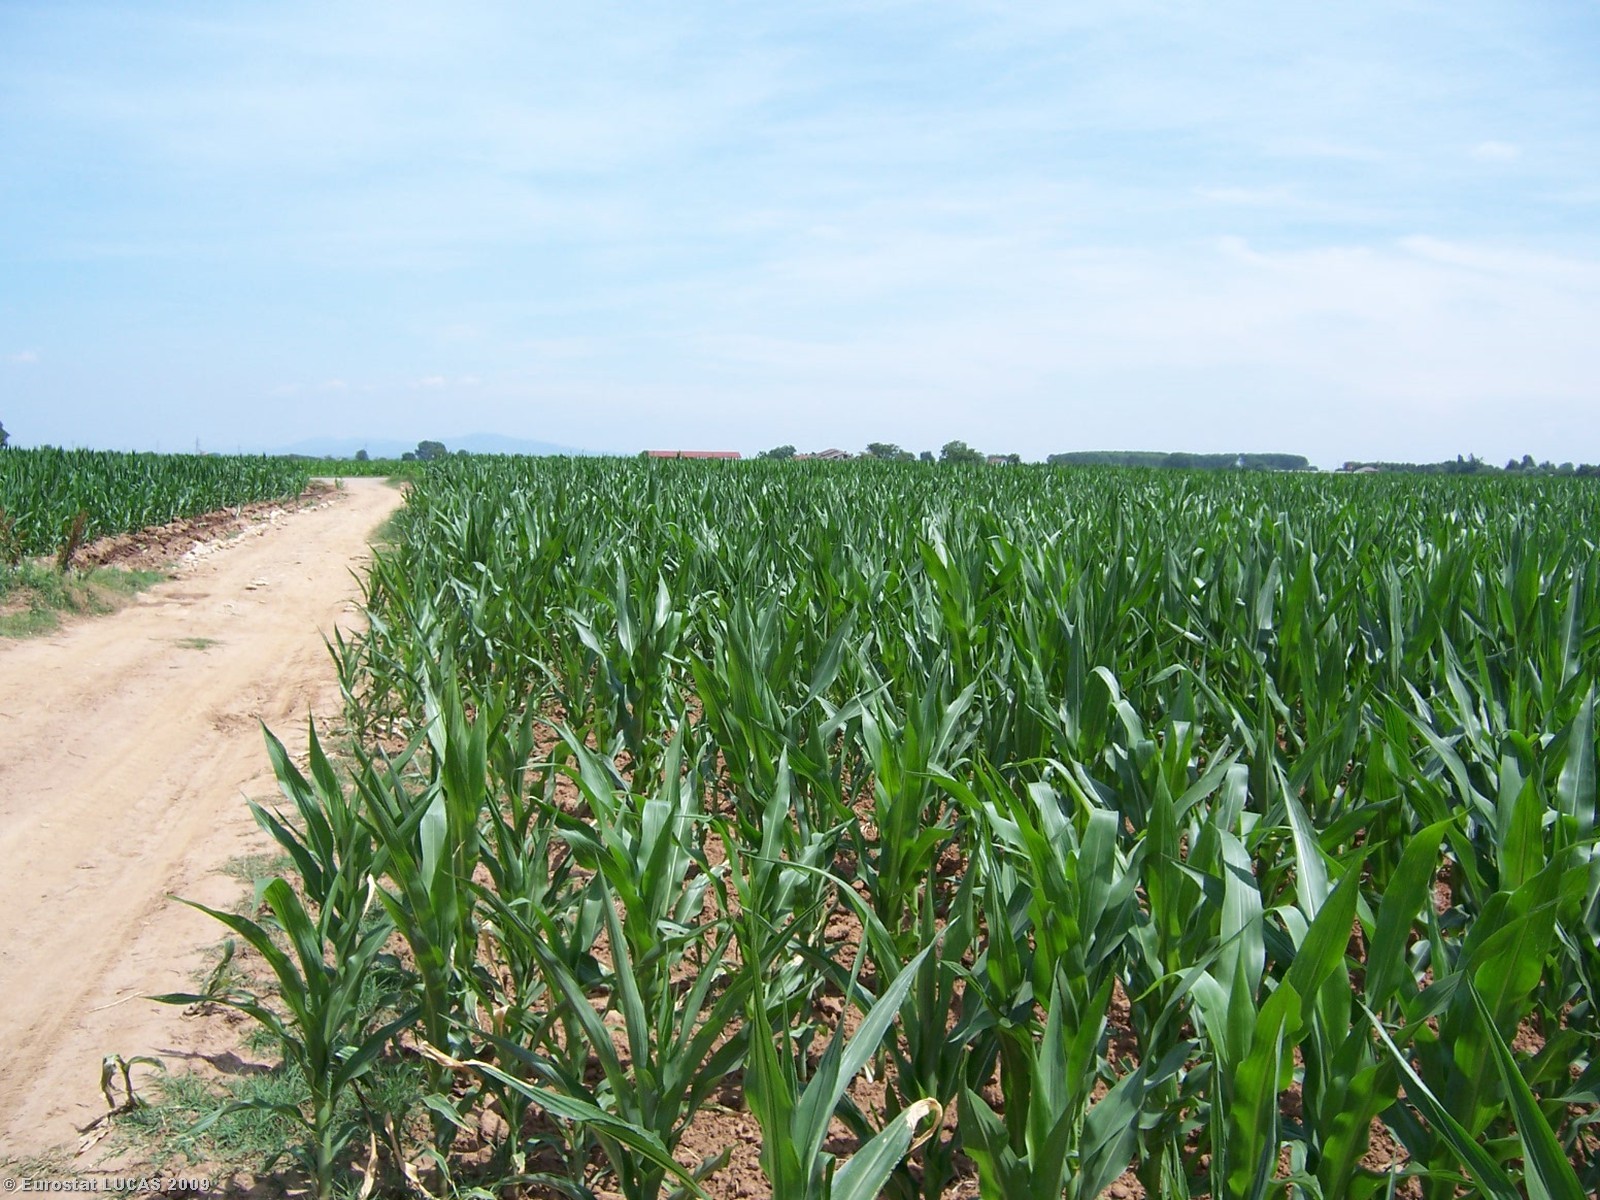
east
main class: Cropland
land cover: Maize
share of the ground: > 75 %
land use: Agriculture (excluding fallow land and kitchen gardens)
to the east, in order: Maize; Common wheat; Grass margins; Common wheat; Grass margins; Paved roads, cycling and walking lanes; Grass margins
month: June
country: IT
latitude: 44.9129
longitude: 7.3827
